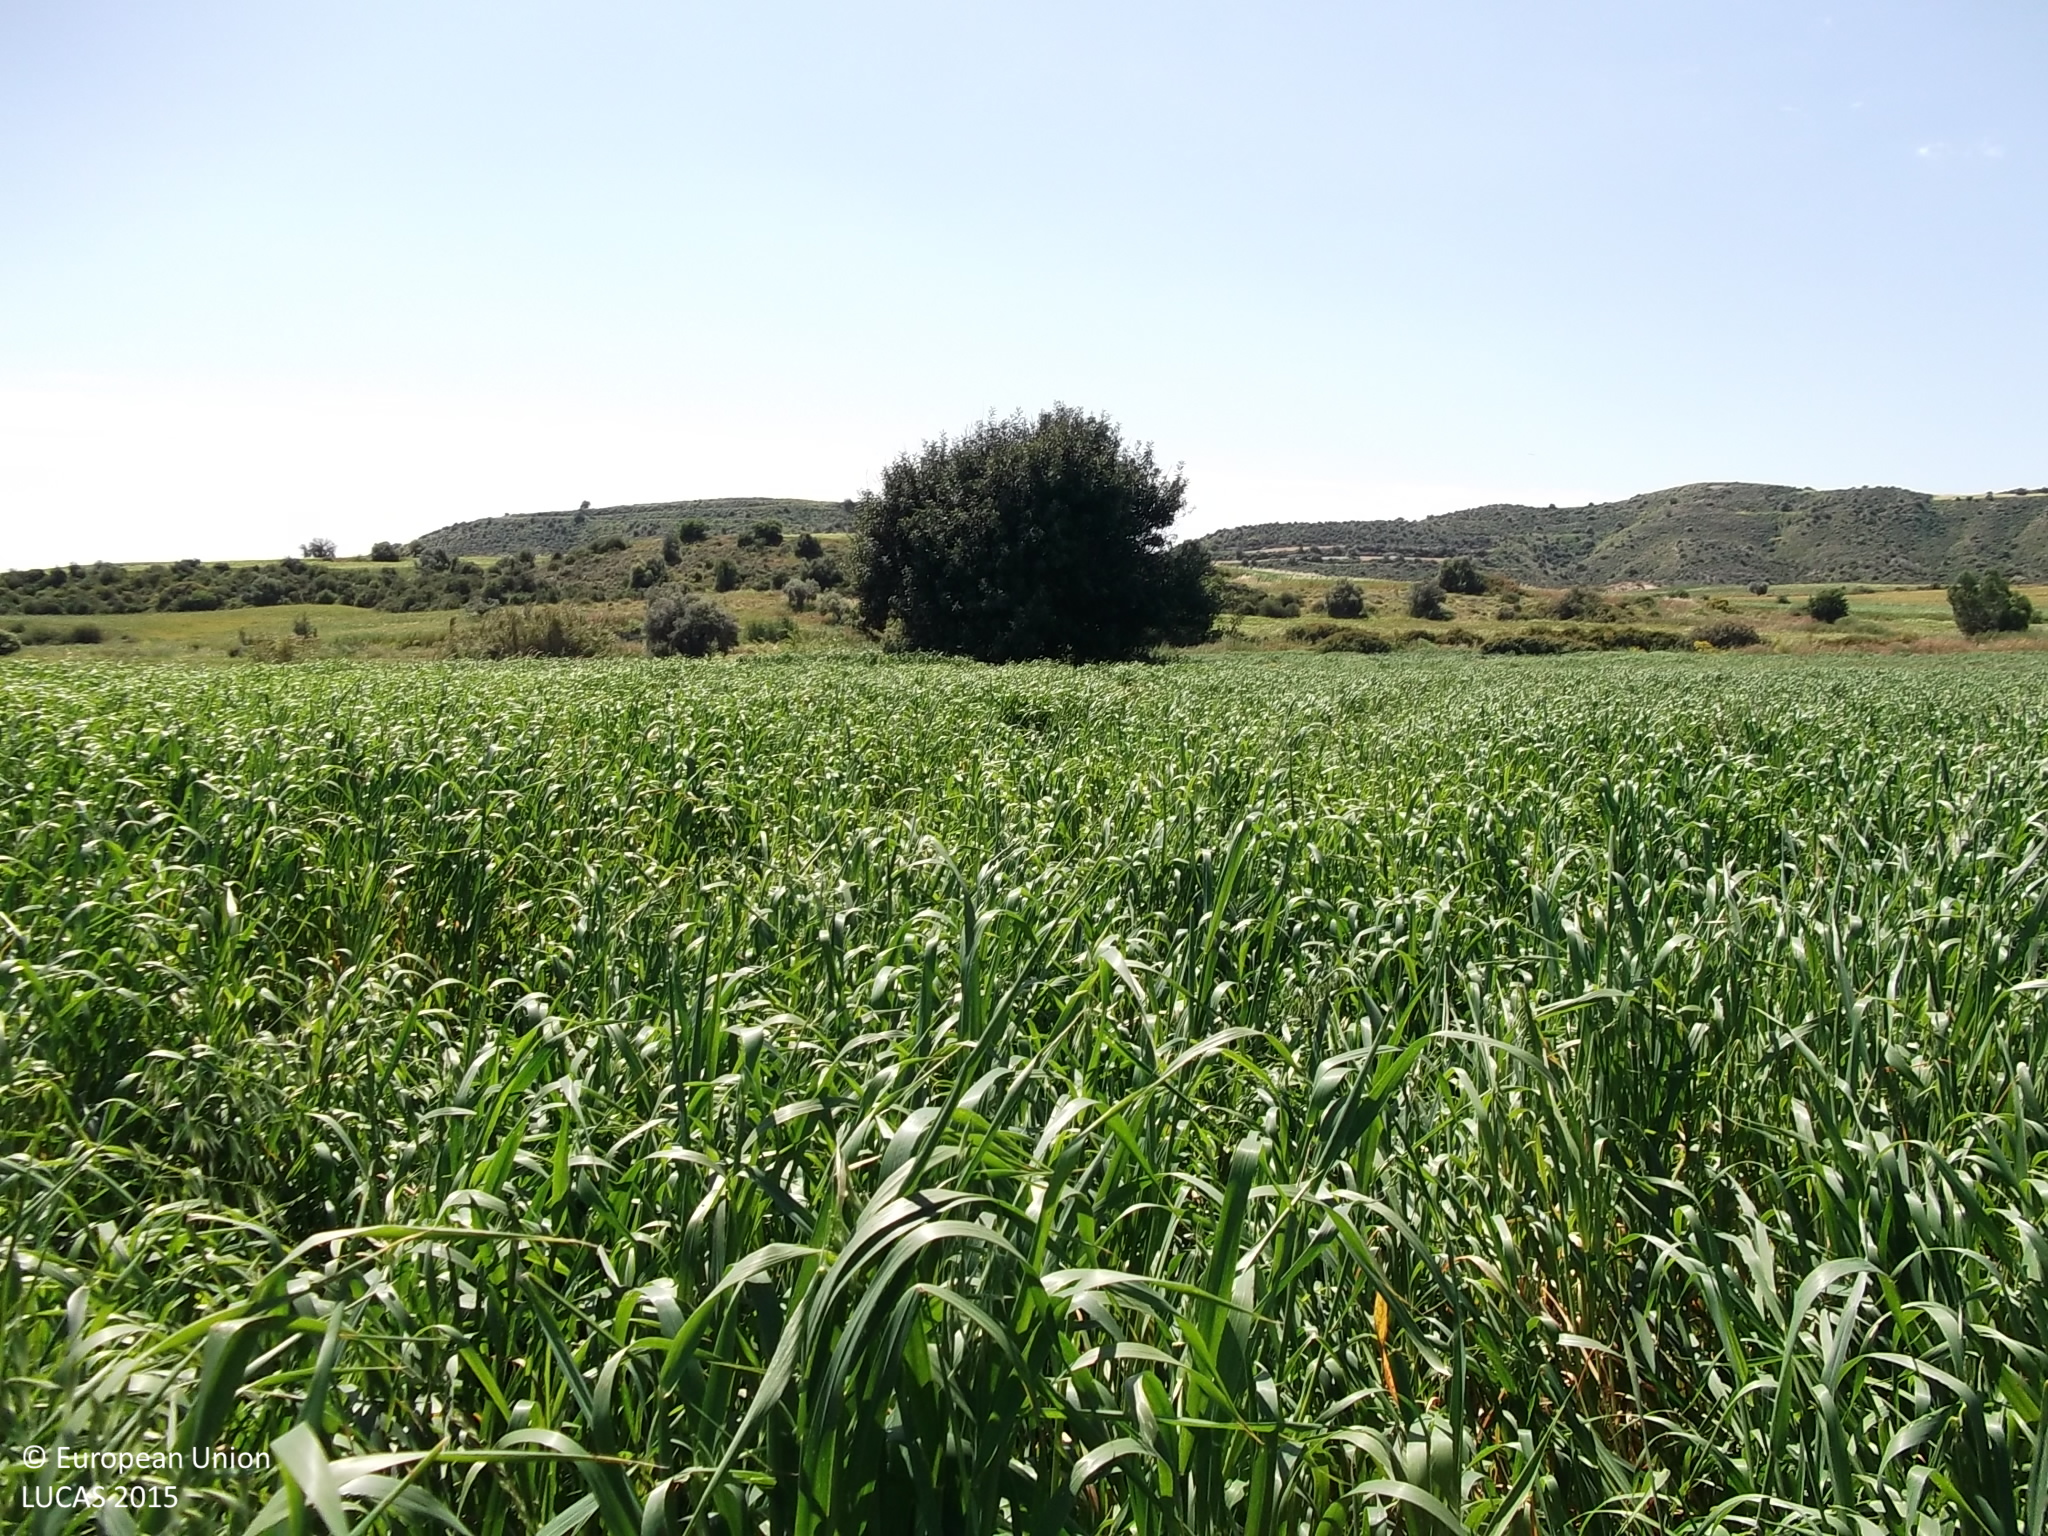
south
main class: Cropland
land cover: Oats
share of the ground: > 75 %
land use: Agriculture (excluding fallow land and kitchen gardens)
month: April
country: CY
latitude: 34.8179
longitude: 33.4160
